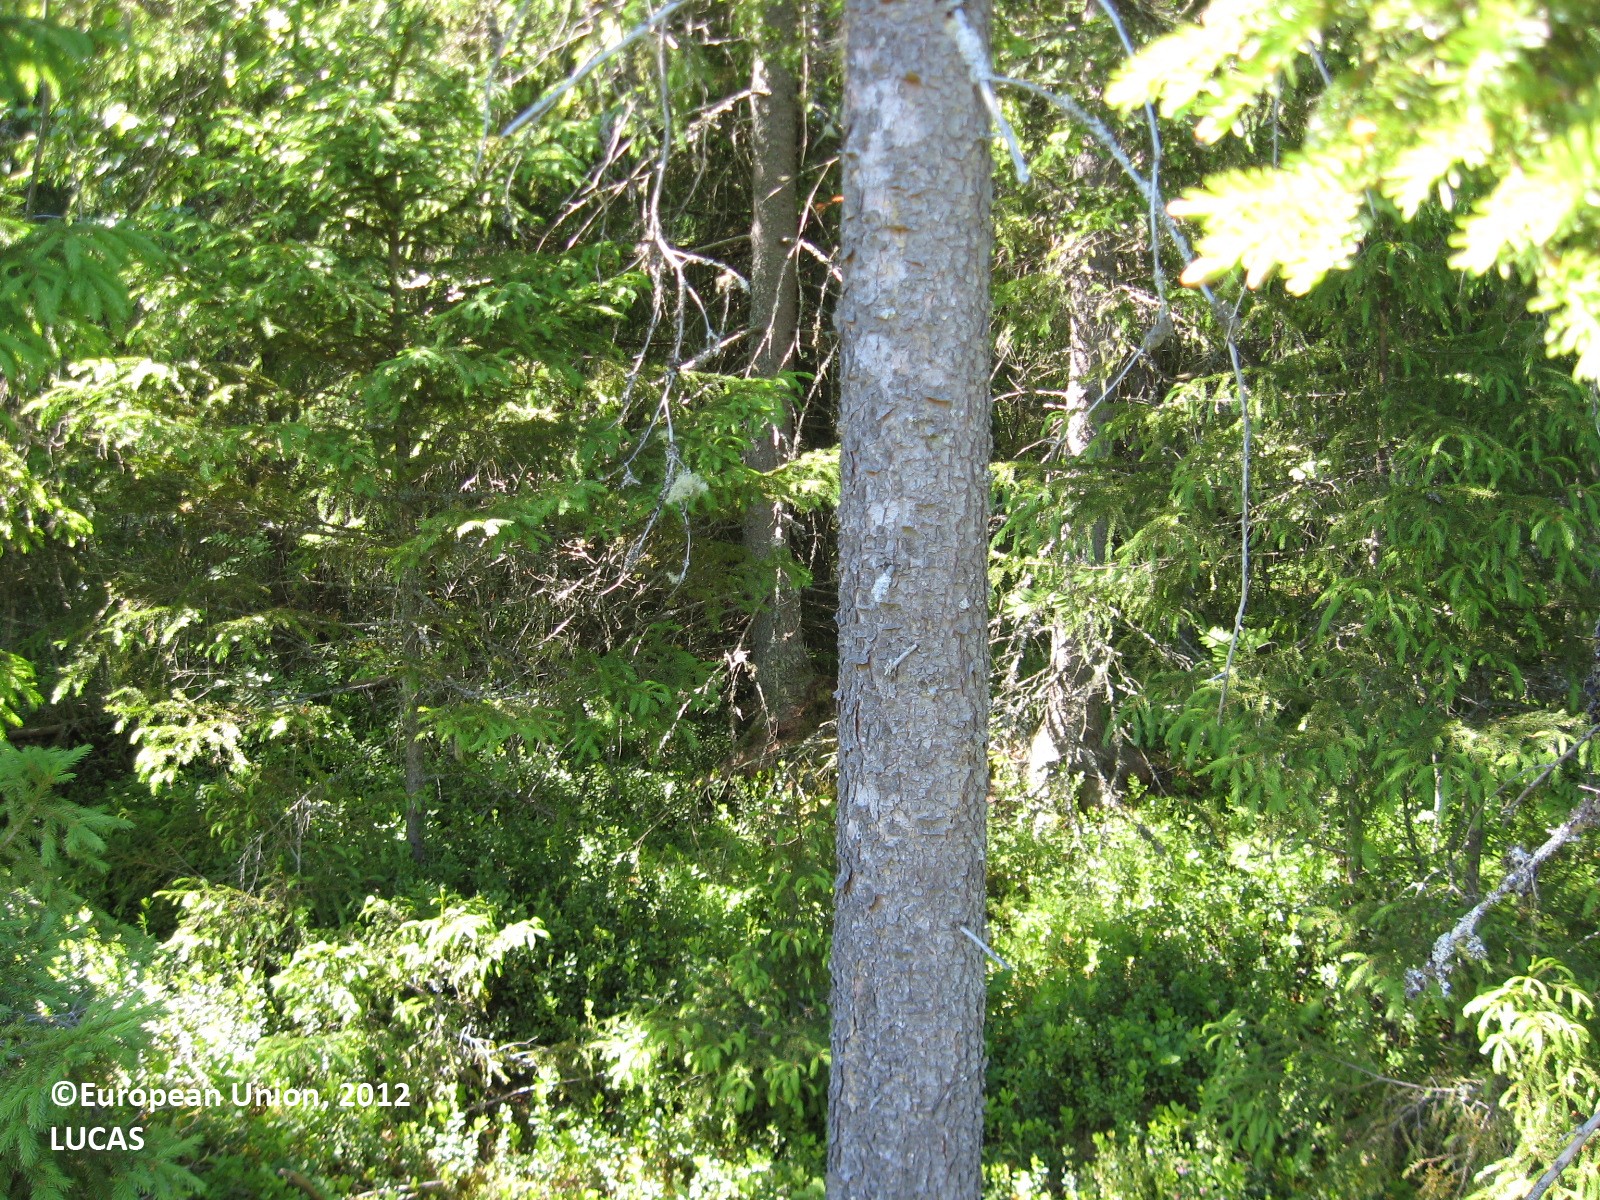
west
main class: Woodland
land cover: Spruce dominated mixed woodland
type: boreal forest
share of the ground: > 75 %
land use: Forestry
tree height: > 5 m
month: June
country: FI
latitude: 62.9913
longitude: 21.7468
